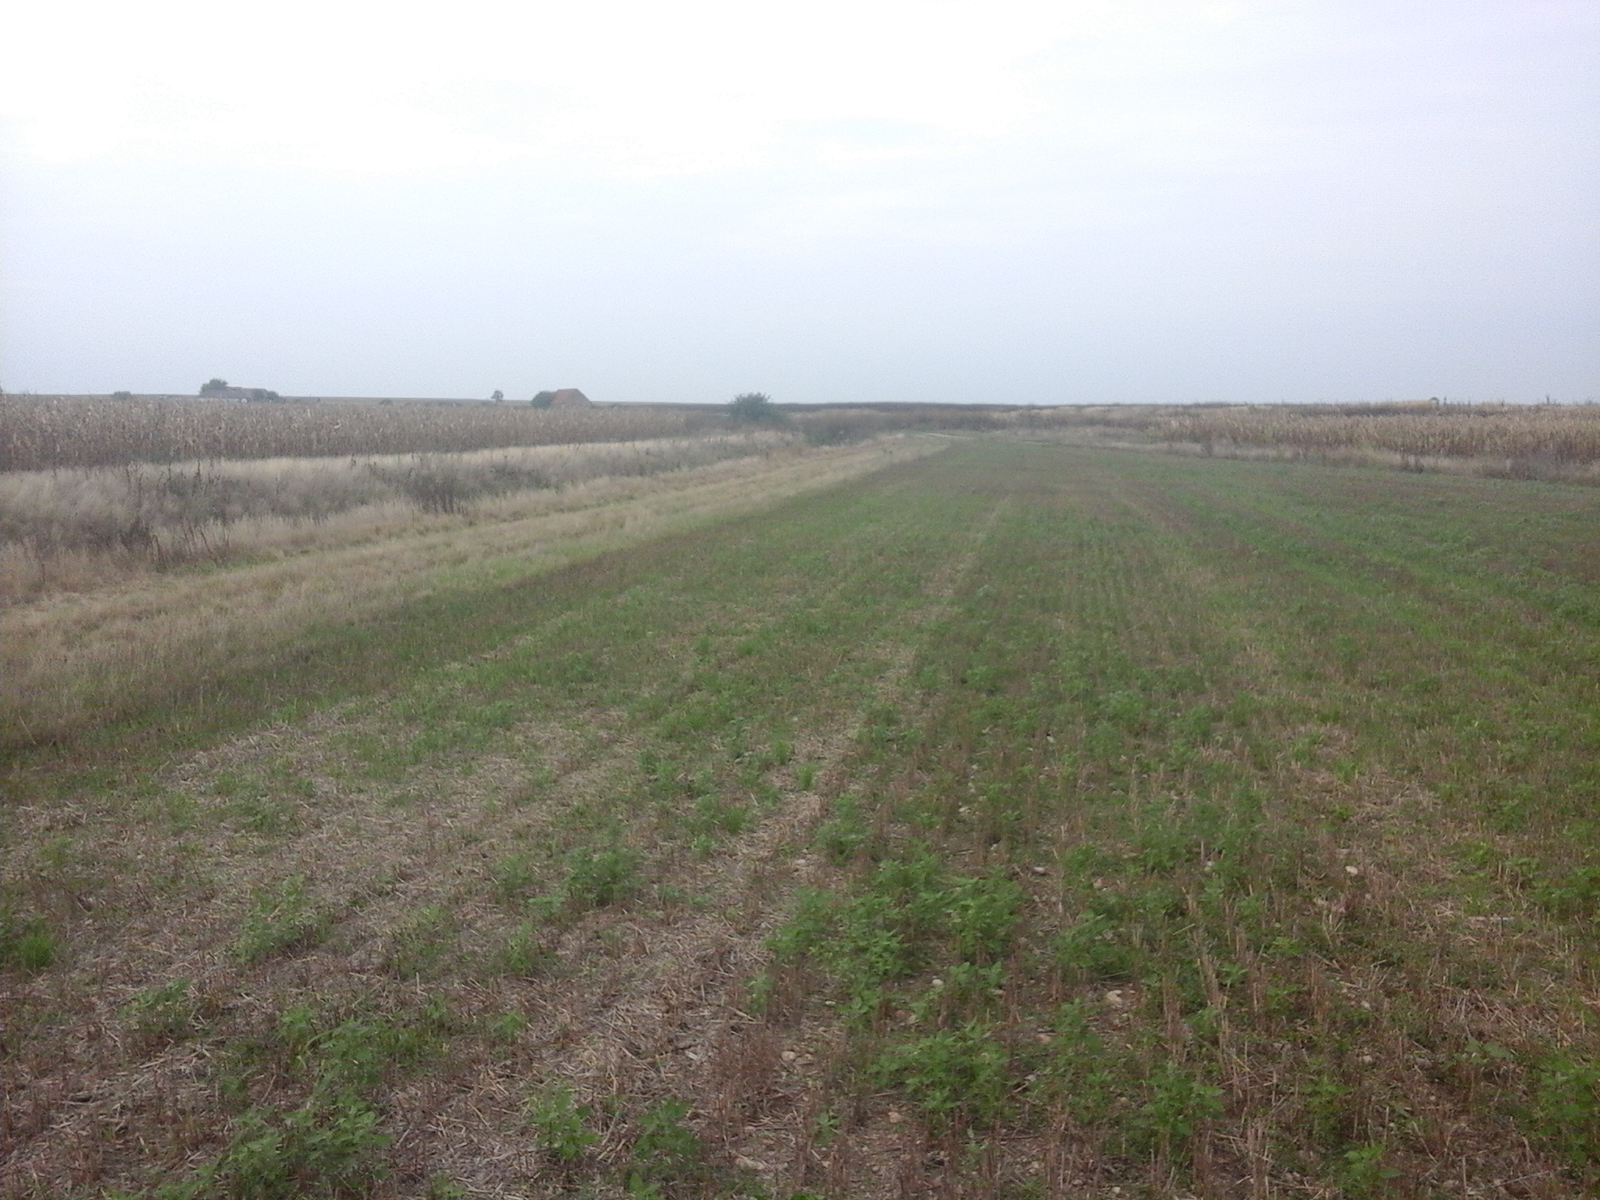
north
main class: Cropland
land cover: Common wheat
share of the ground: < 10 %
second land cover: Spontaneously vegetated surfaces
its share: 50 - 75 %
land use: Agriculture (excluding fallow land and kitchen gardens)
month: August
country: RO
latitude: 46.2365
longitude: 21.5130
